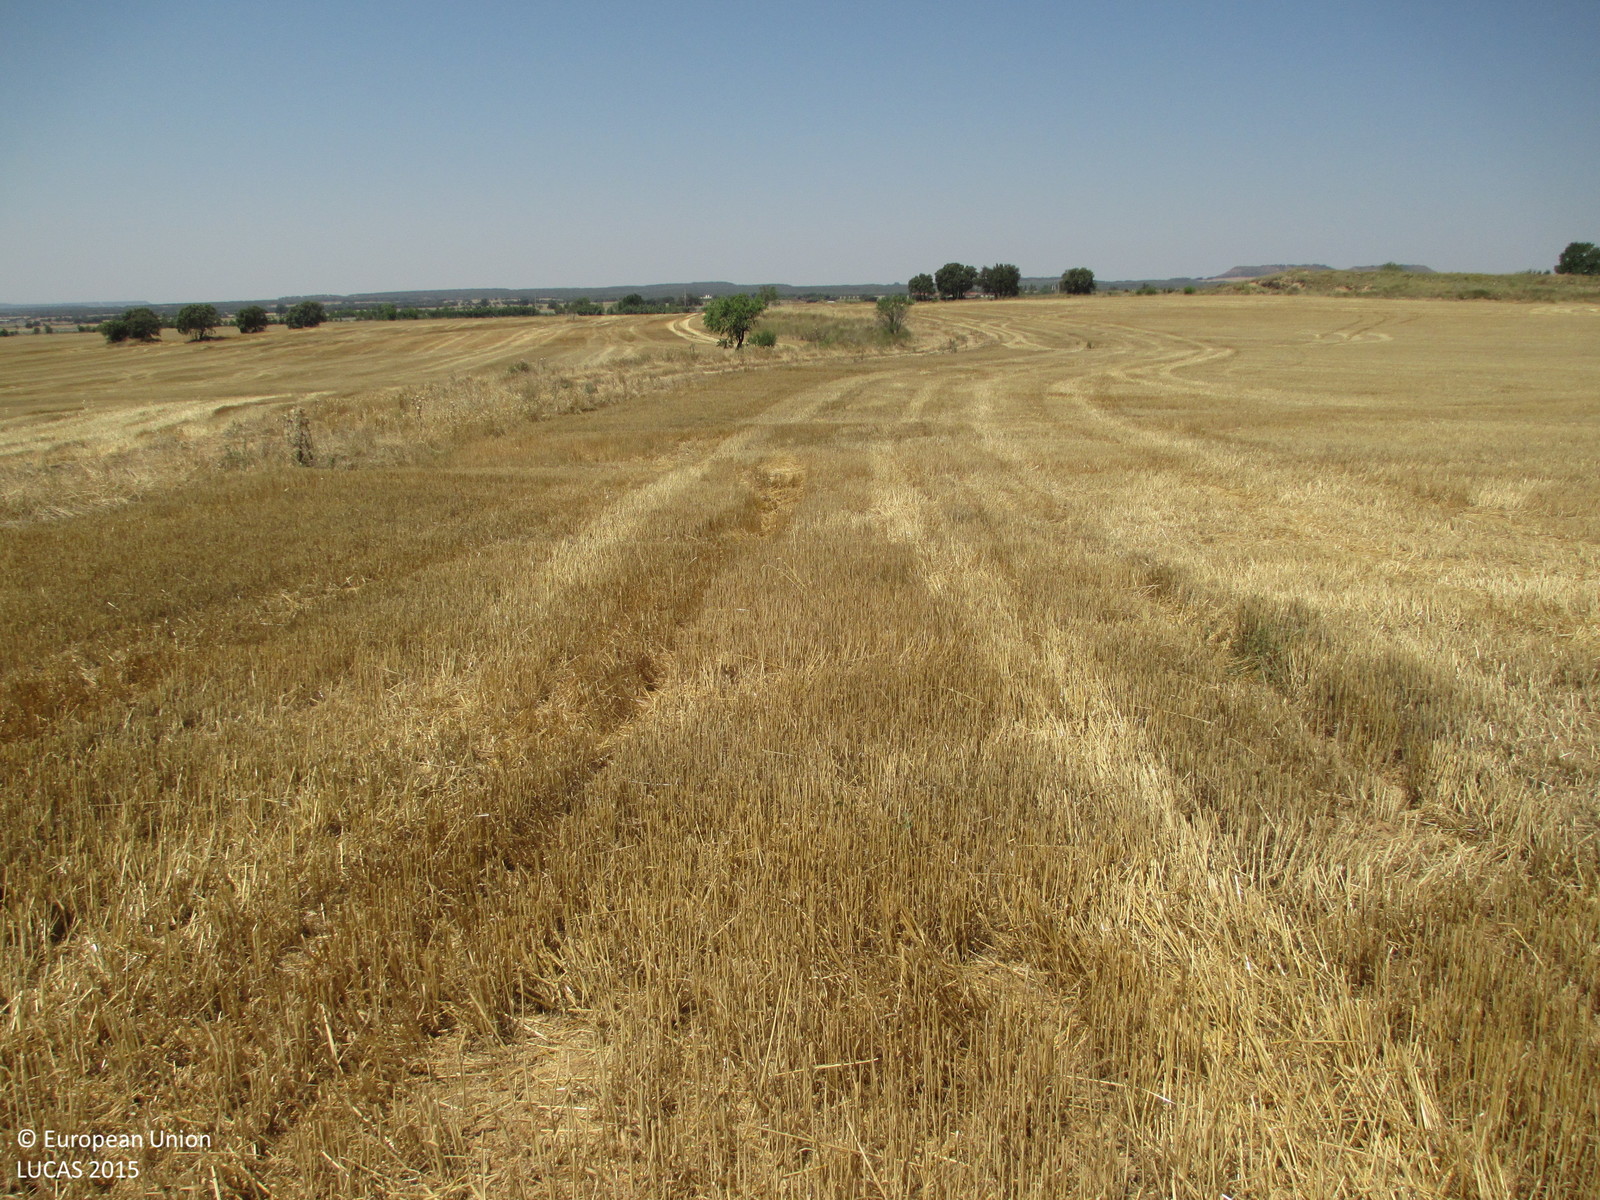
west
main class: Cropland
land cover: Common wheat
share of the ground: < 10 %
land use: Agriculture (excluding fallow land and kitchen gardens)
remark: Harvested field
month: June
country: ES
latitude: 42.2054
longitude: -0.4273
